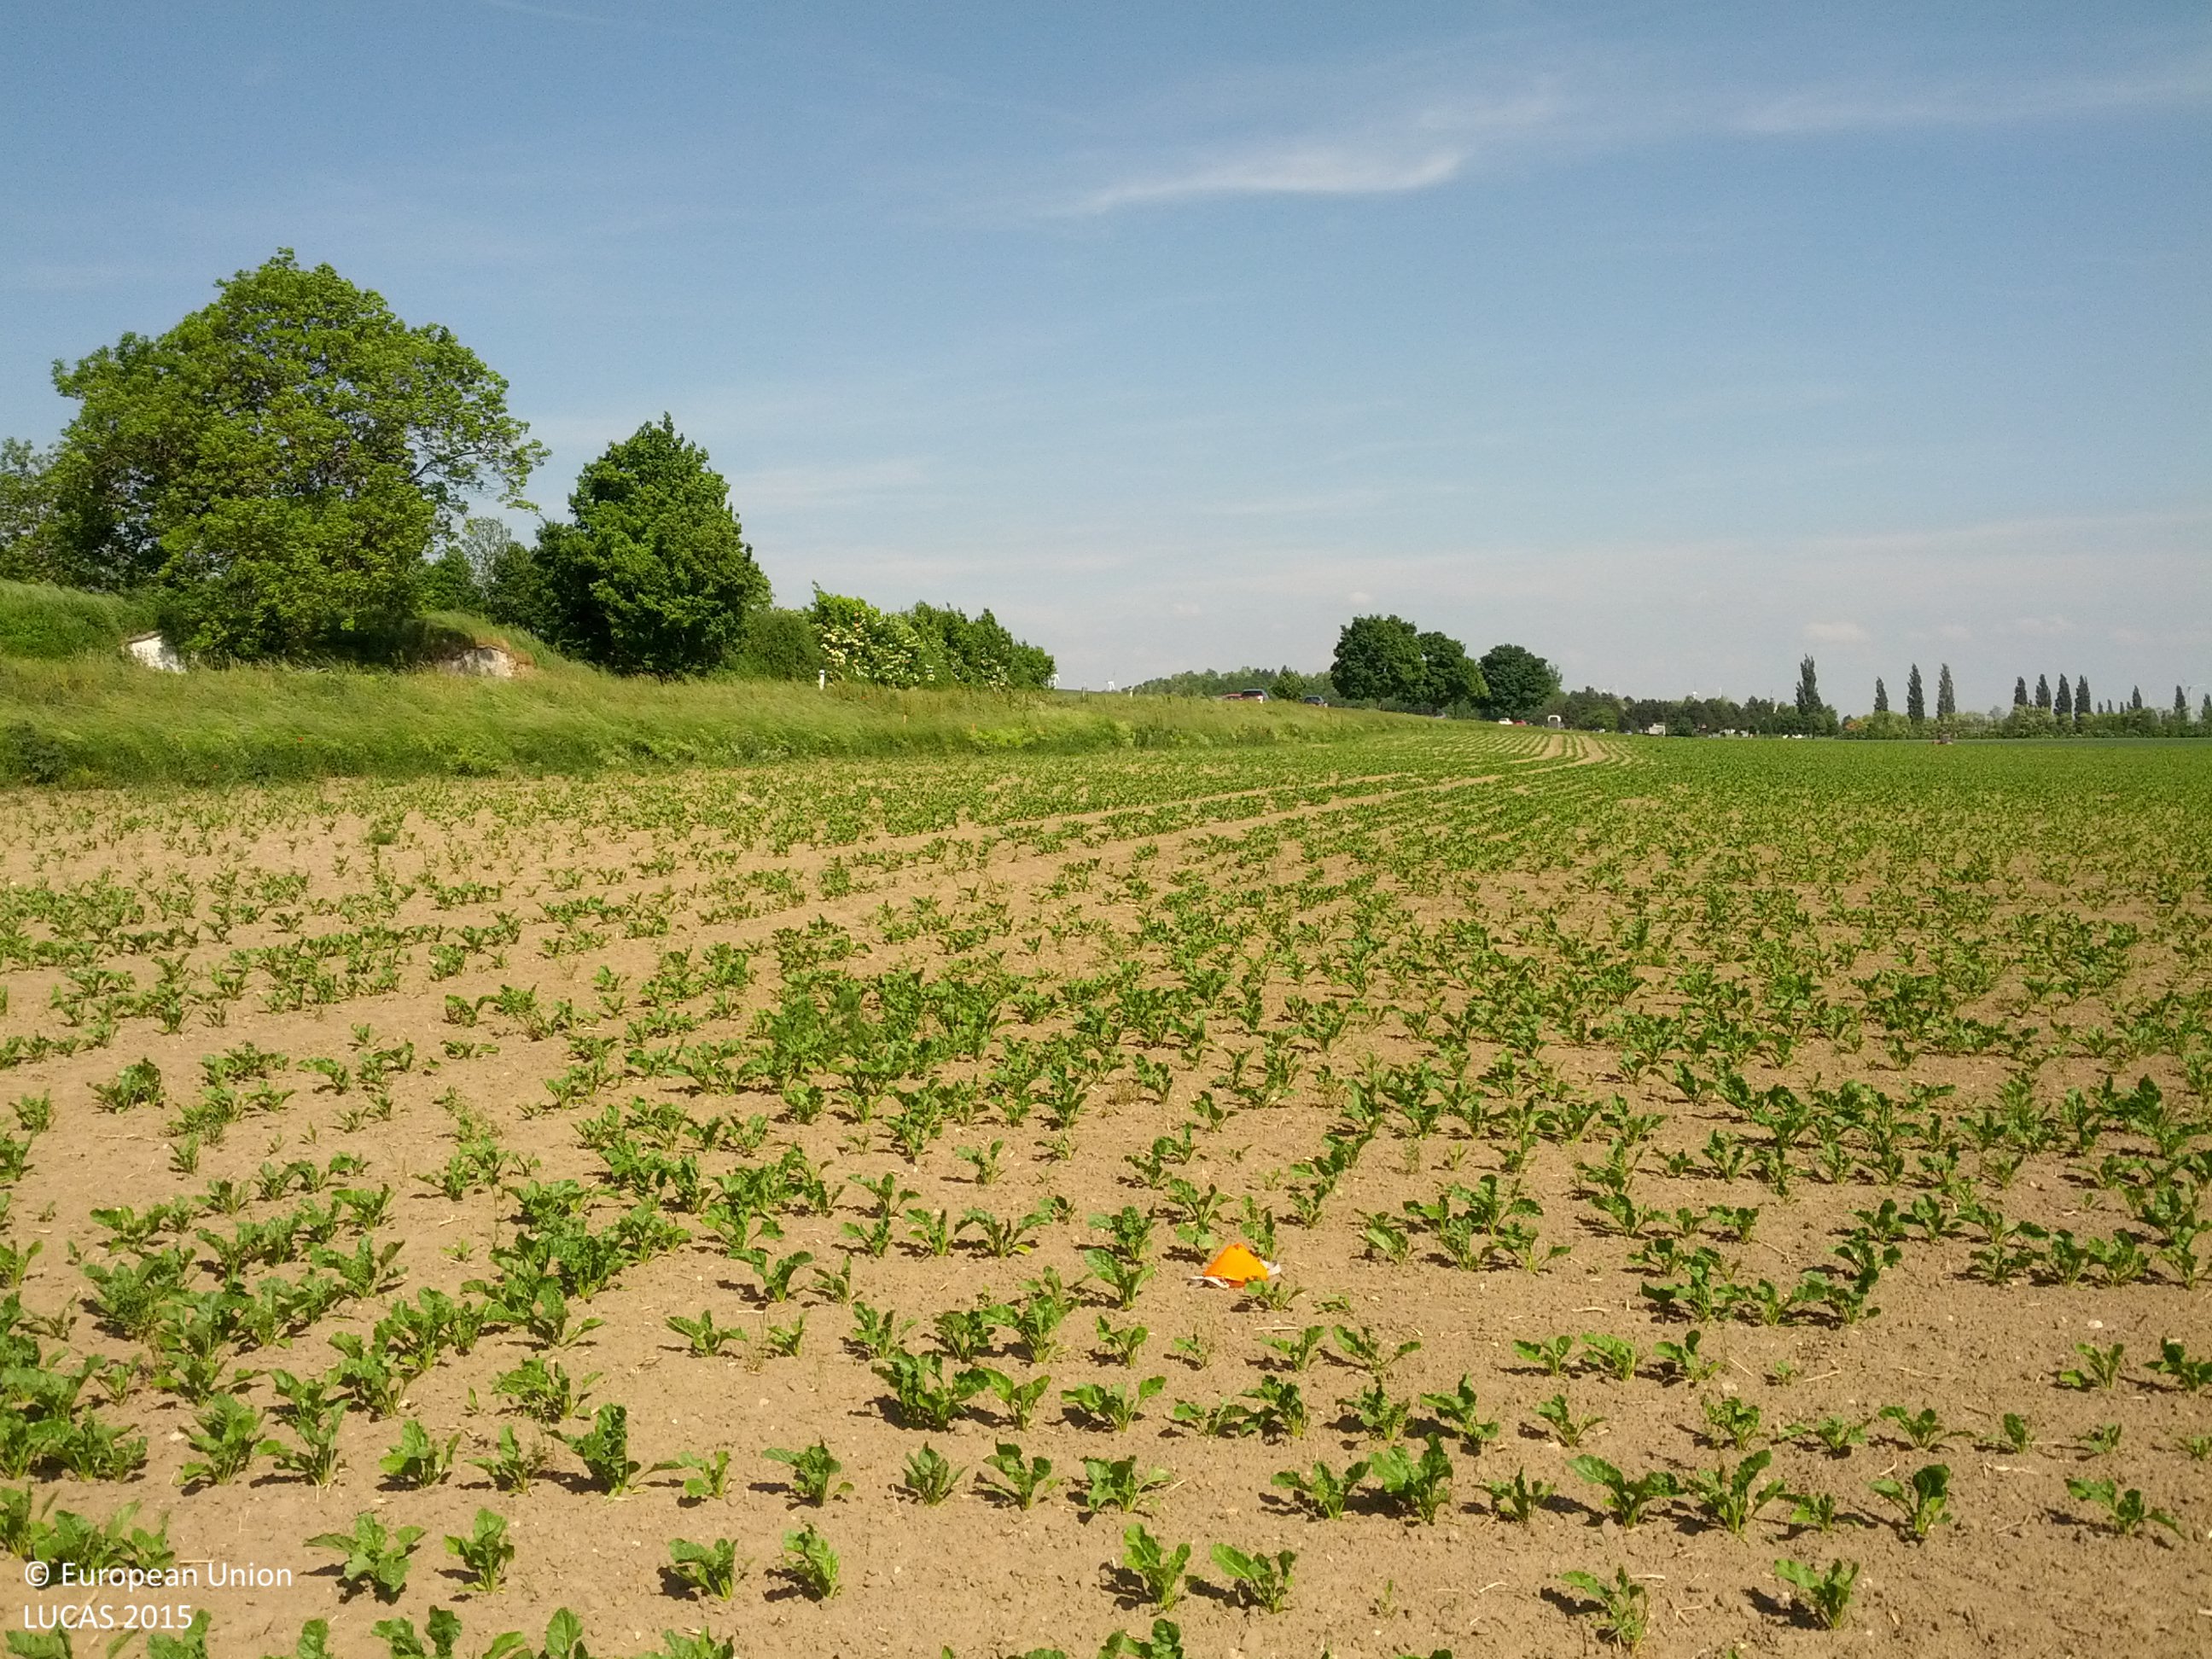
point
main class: Cropland
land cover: Sugar beet
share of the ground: < 10 %
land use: Agriculture (excluding fallow land and kitchen gardens)
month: May
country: AT
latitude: 48.0606
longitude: 16.6208
